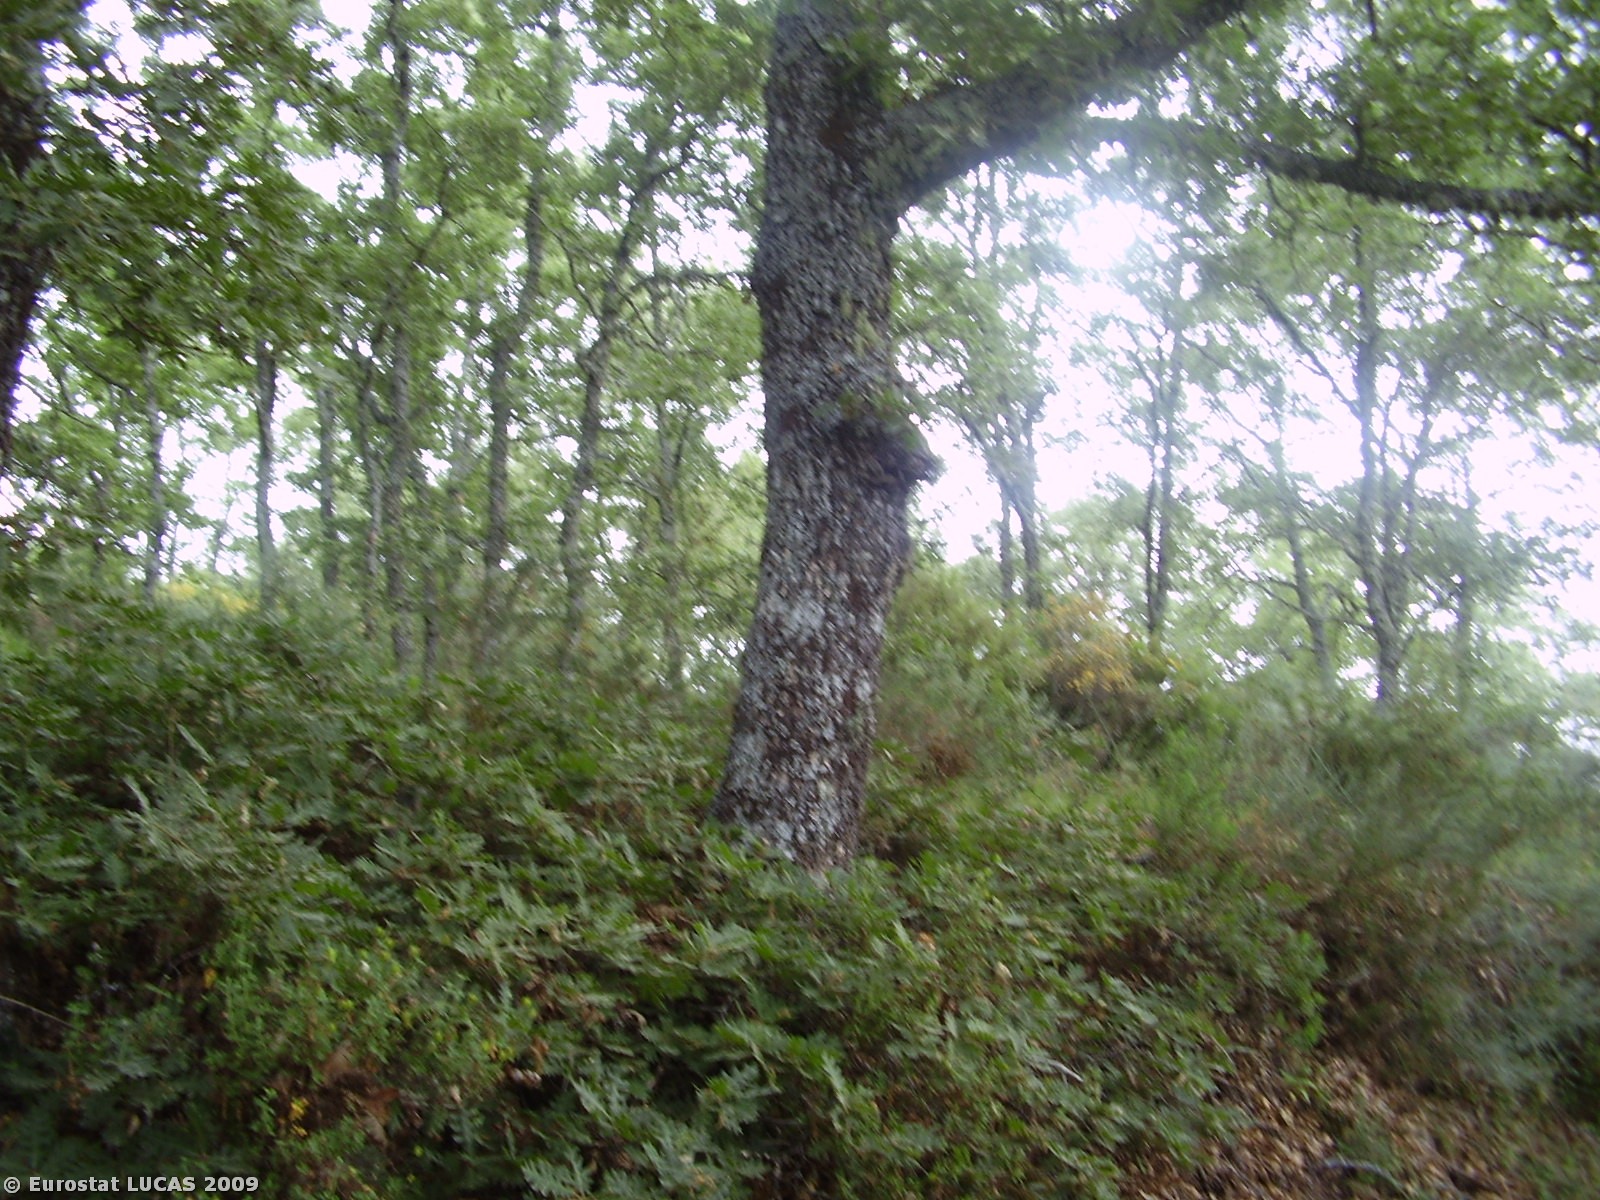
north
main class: Woodland
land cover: Broadleaved woodland
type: acidophilous oak and oak-birch forest
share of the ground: > 75 %
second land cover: Spontaneously vegetated surfaces
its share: 25 - 50 %
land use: Forestry
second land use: Nature reserves
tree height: > 5 m
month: June
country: PT
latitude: 41.7122
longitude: -6.8317
